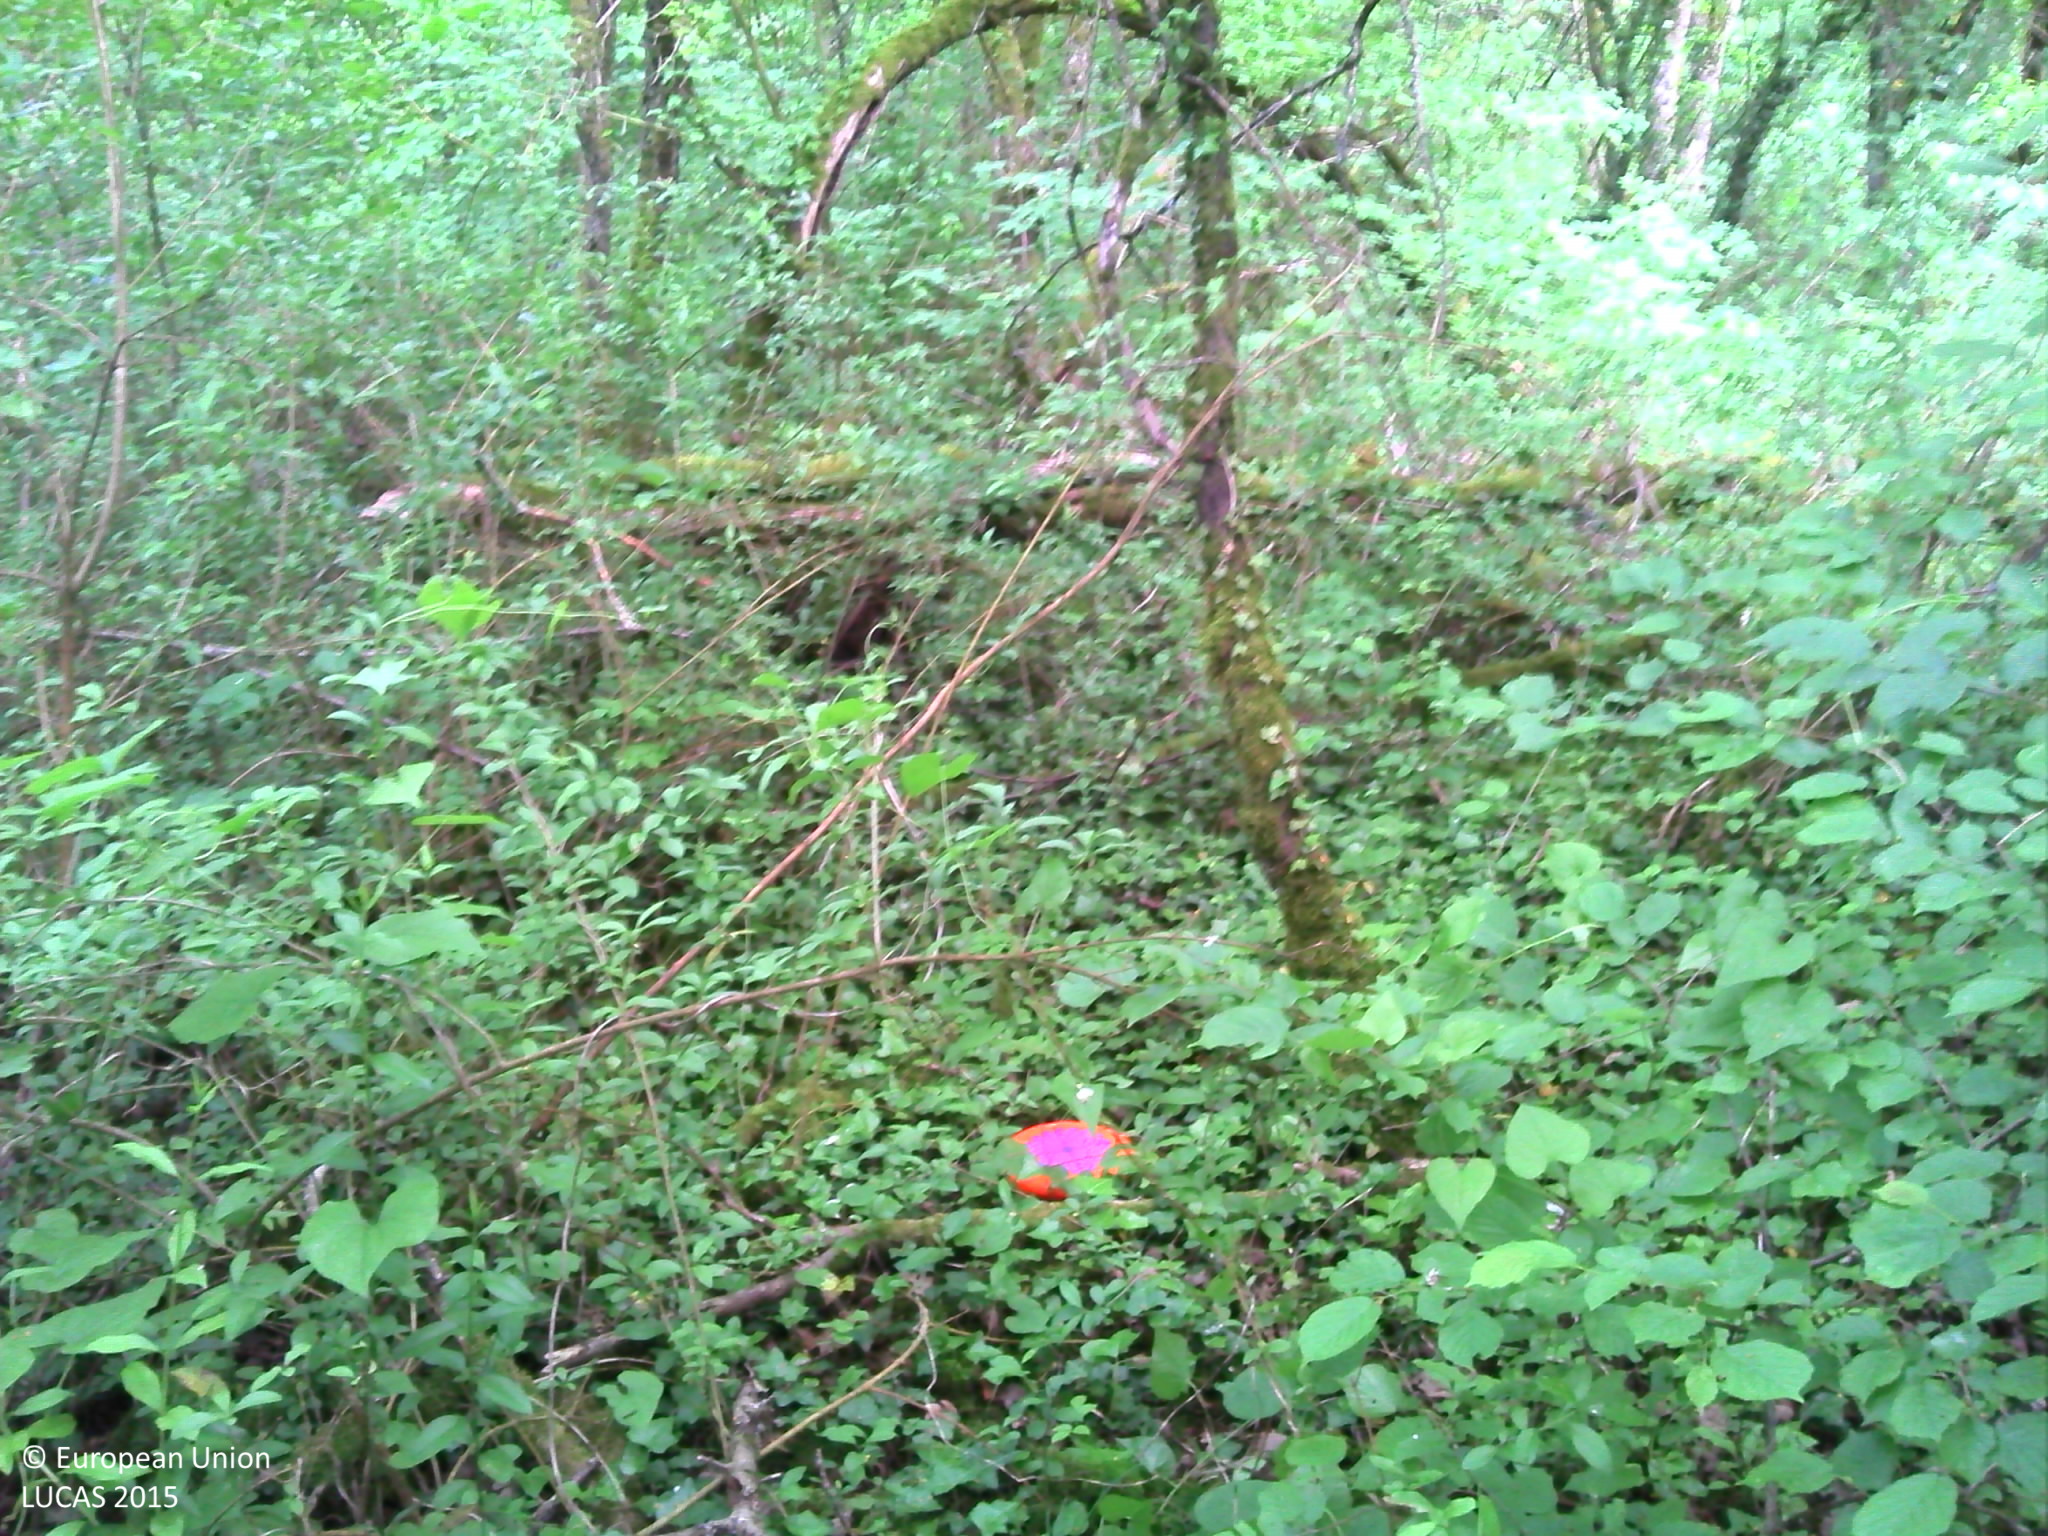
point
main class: Woodland
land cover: Broadleaved woodland
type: mesophytic deciduous forest
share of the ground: > 75 %
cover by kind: broadleaved forest trees 90 %, herbaceous plants 5 %, lichens and mosses 5 %
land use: Forestry
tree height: > 5 m
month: May
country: FR
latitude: 47.8232
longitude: 4.2944
